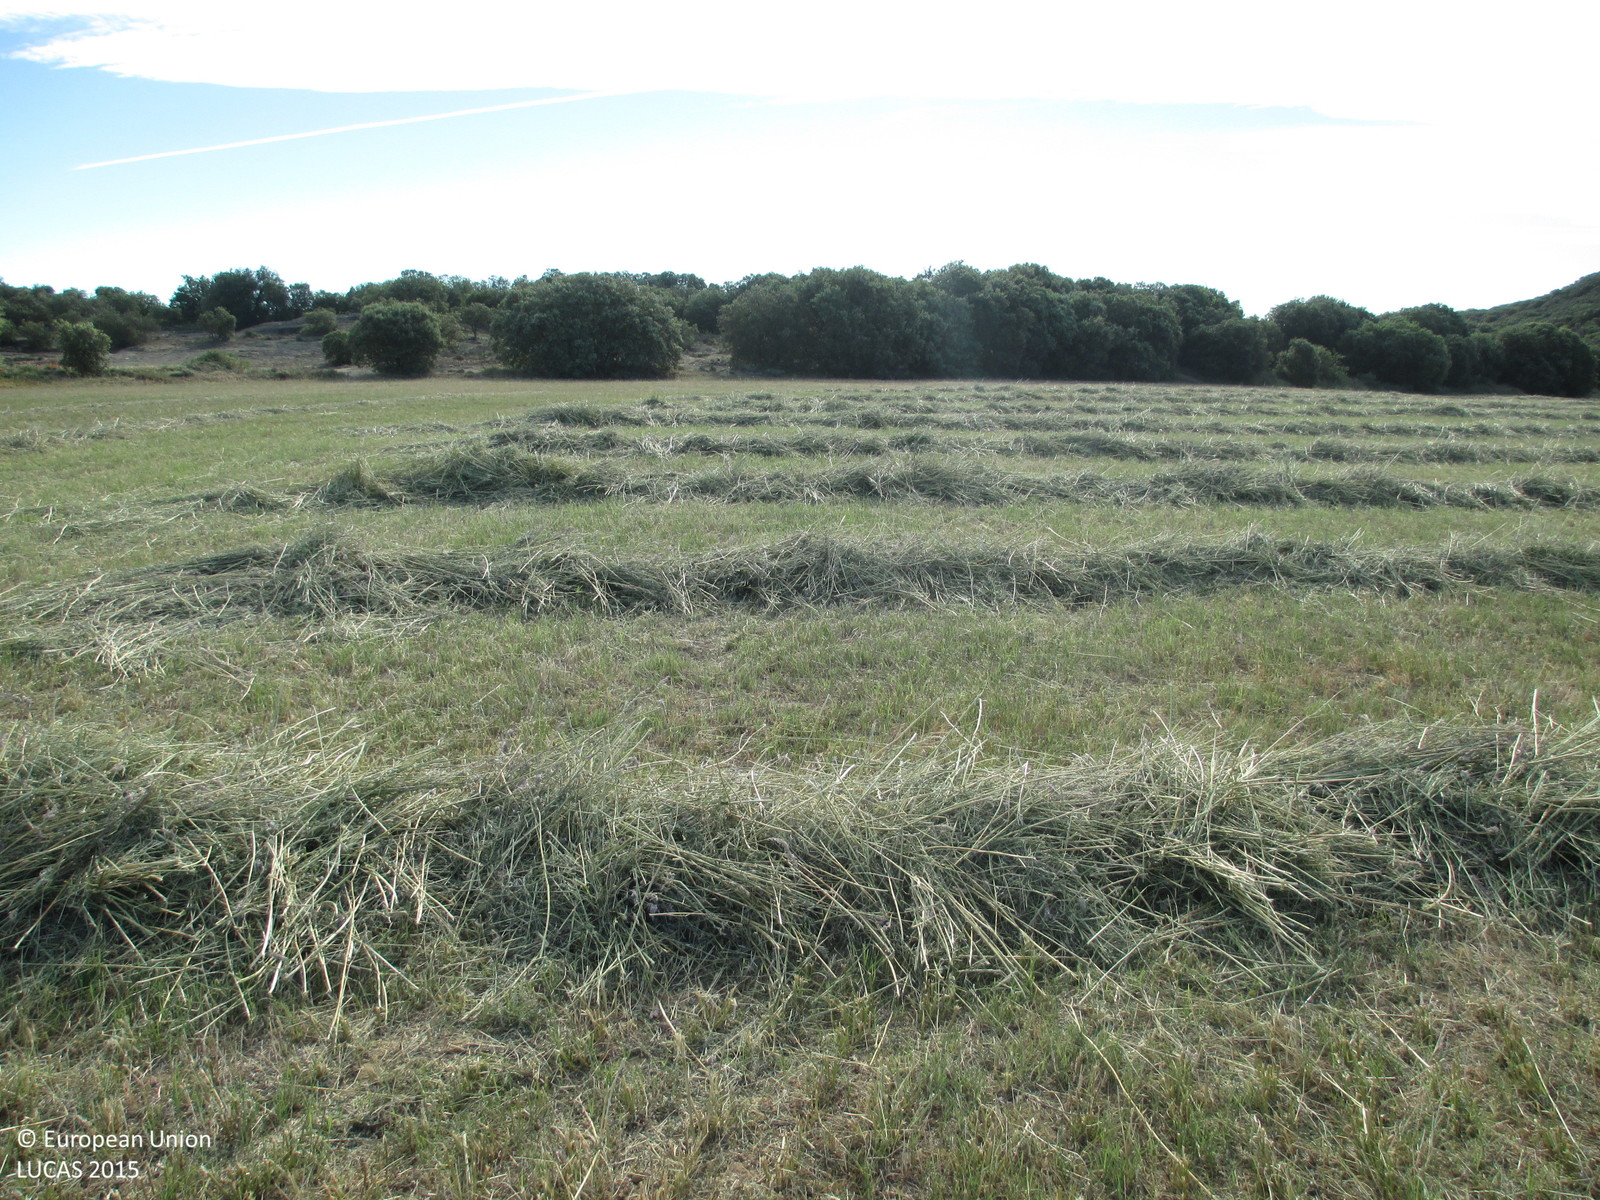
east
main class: Cropland
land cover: Lucerne
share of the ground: > 75 %
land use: Agriculture (excluding fallow land and kitchen gardens)
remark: Harvested field
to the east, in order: Lucerne; Broadleaved woodland; Rivers and streams; Broadleaved woodland; Tracks; Grass margins; Spontaneously vegetated surfaces; Broadleaved woodland; Spontaneously vegetated surfaces; Single bushes/trees; Tracks; Spontaneously vegetated surfaces
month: May
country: ES
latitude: 42.0951
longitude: -0.2621
